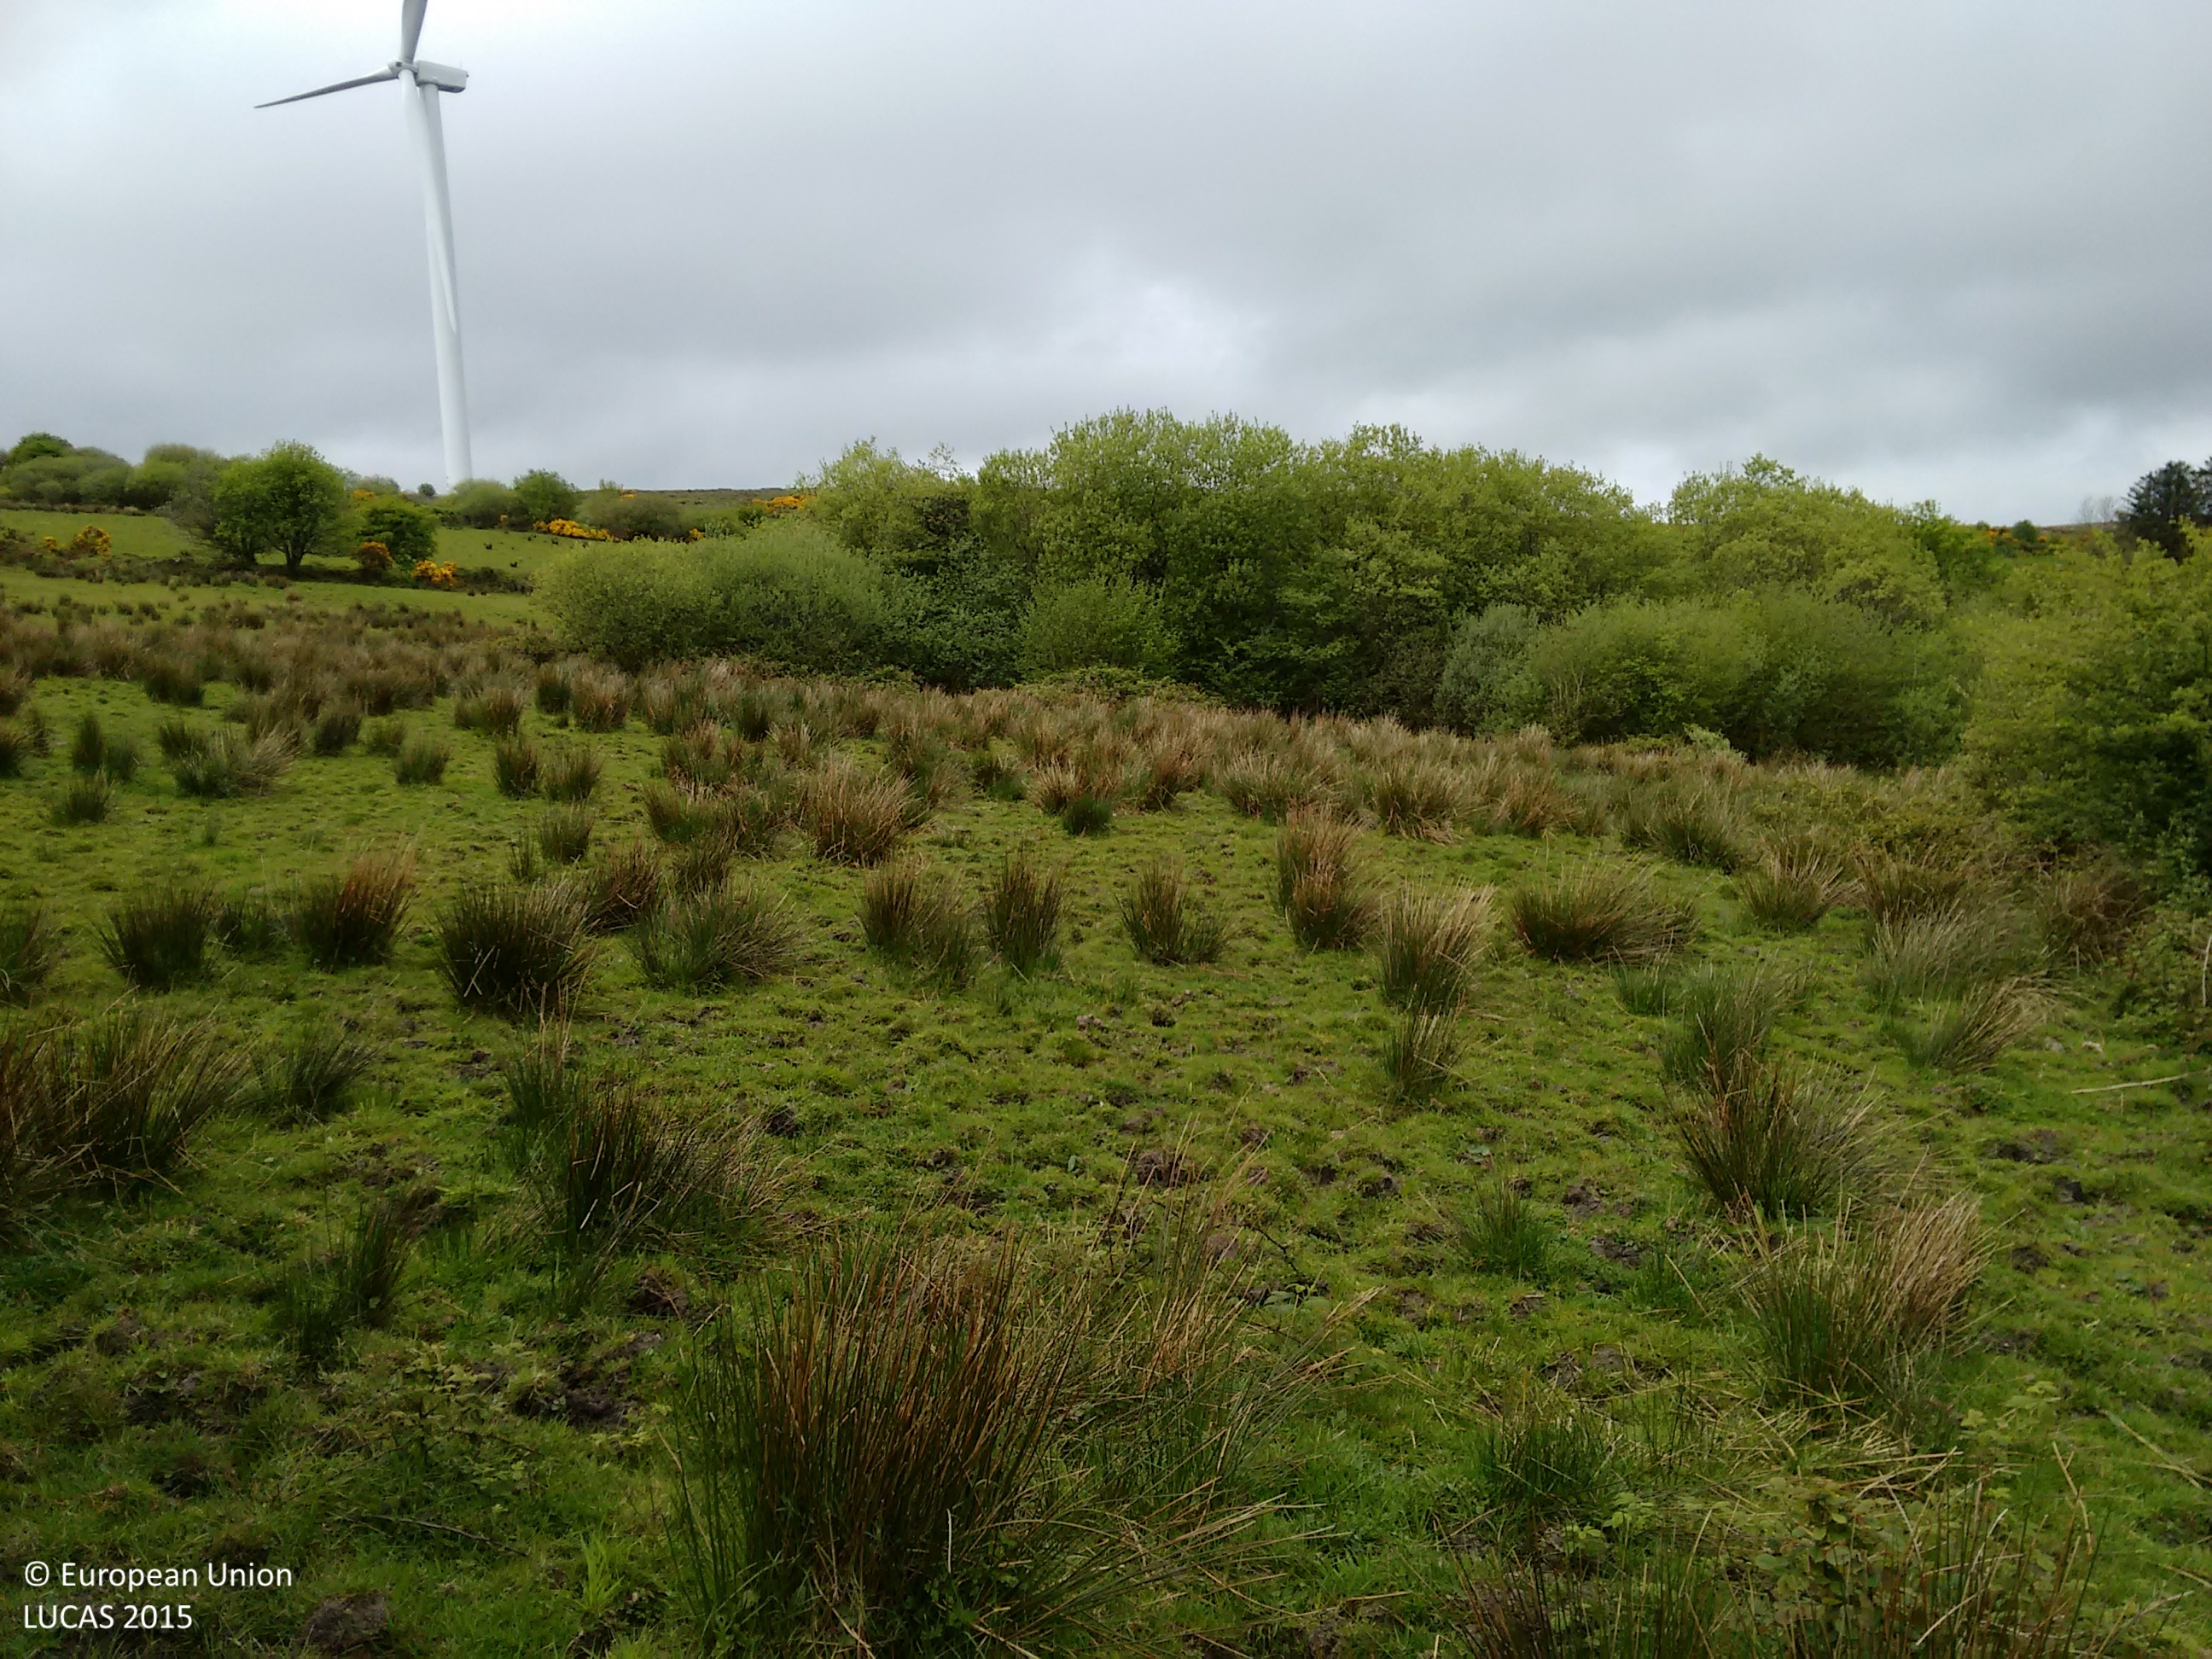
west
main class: Grassland
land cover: Grassland without tree/shrub cover
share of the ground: > 75 %
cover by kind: herbaceous plants 100 %
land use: Agriculture (excluding fallow land and kitchen gardens)
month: May
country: IE
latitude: 52.1870
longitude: -8.0976
